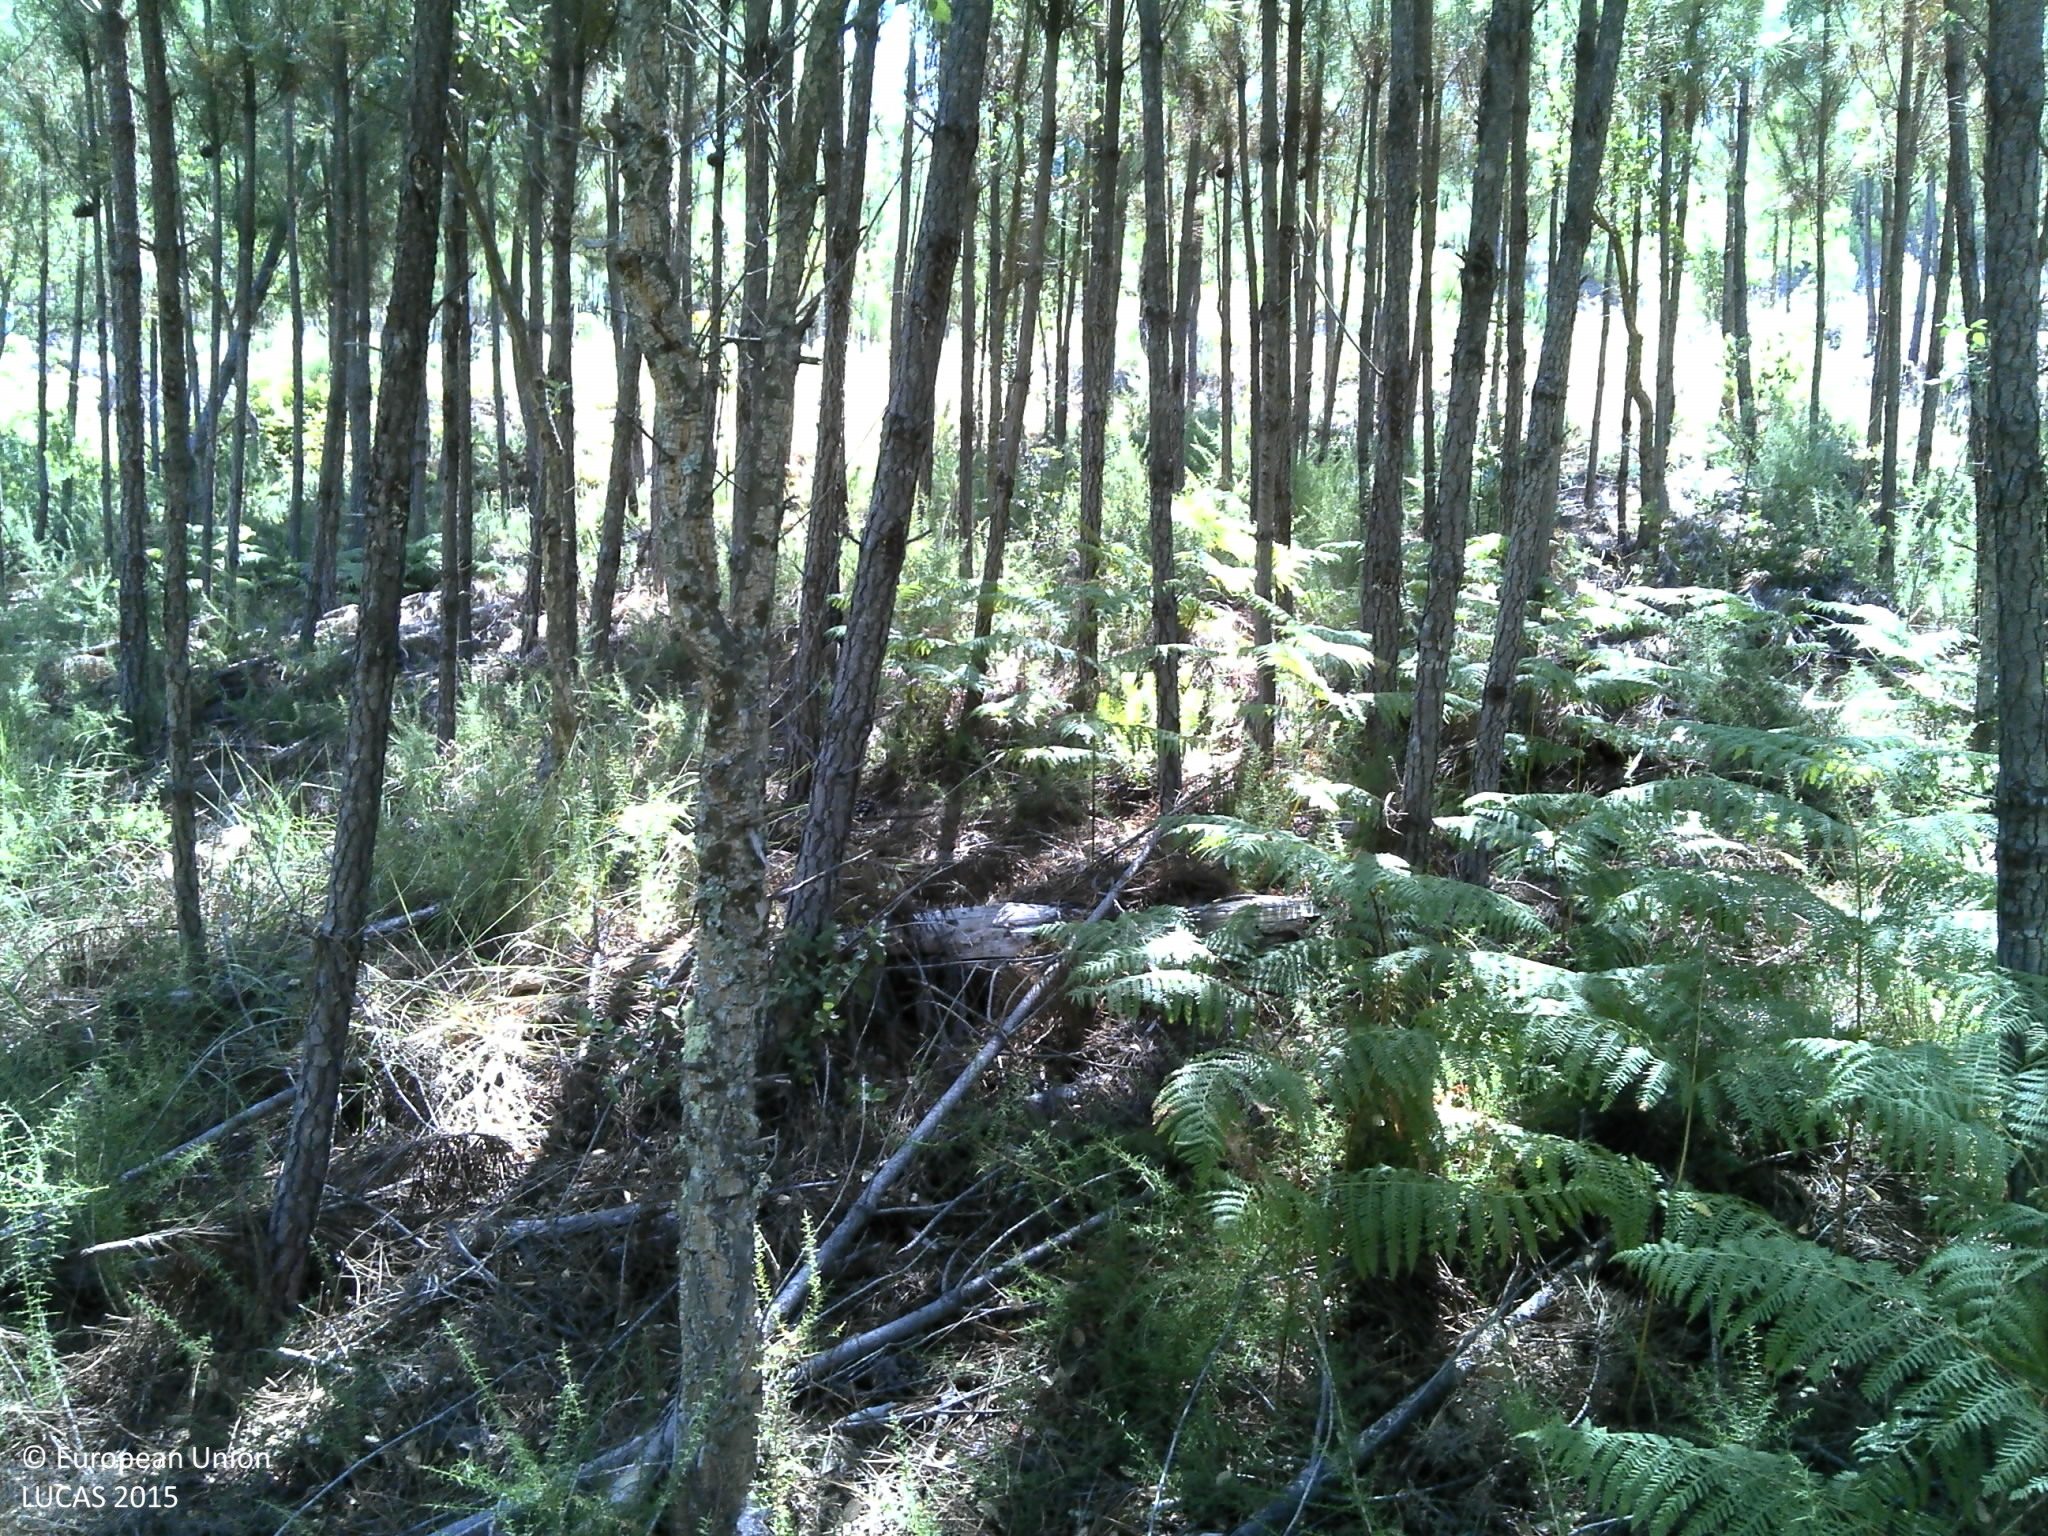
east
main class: Woodland
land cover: Pine dominated coniferous woodland
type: coniferous forest of the mediterranean region
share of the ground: 50 - 75 %
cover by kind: coniferous forest trees 50 %, shrubs 20 %, unconsolidated bare surface 10 %
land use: Forestry
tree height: > 5 m
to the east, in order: Pine dominated coniferous woodland; Grass margins; Paved roads, cycling and walking lanes; Grass margins; Pine dominated coniferous woodland; Pine dominated mixed woodland; Tracks; Pine dominated mixed woodland; Shrubland with sparse tree cover
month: July
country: PT
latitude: 39.7252
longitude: -8.1386
